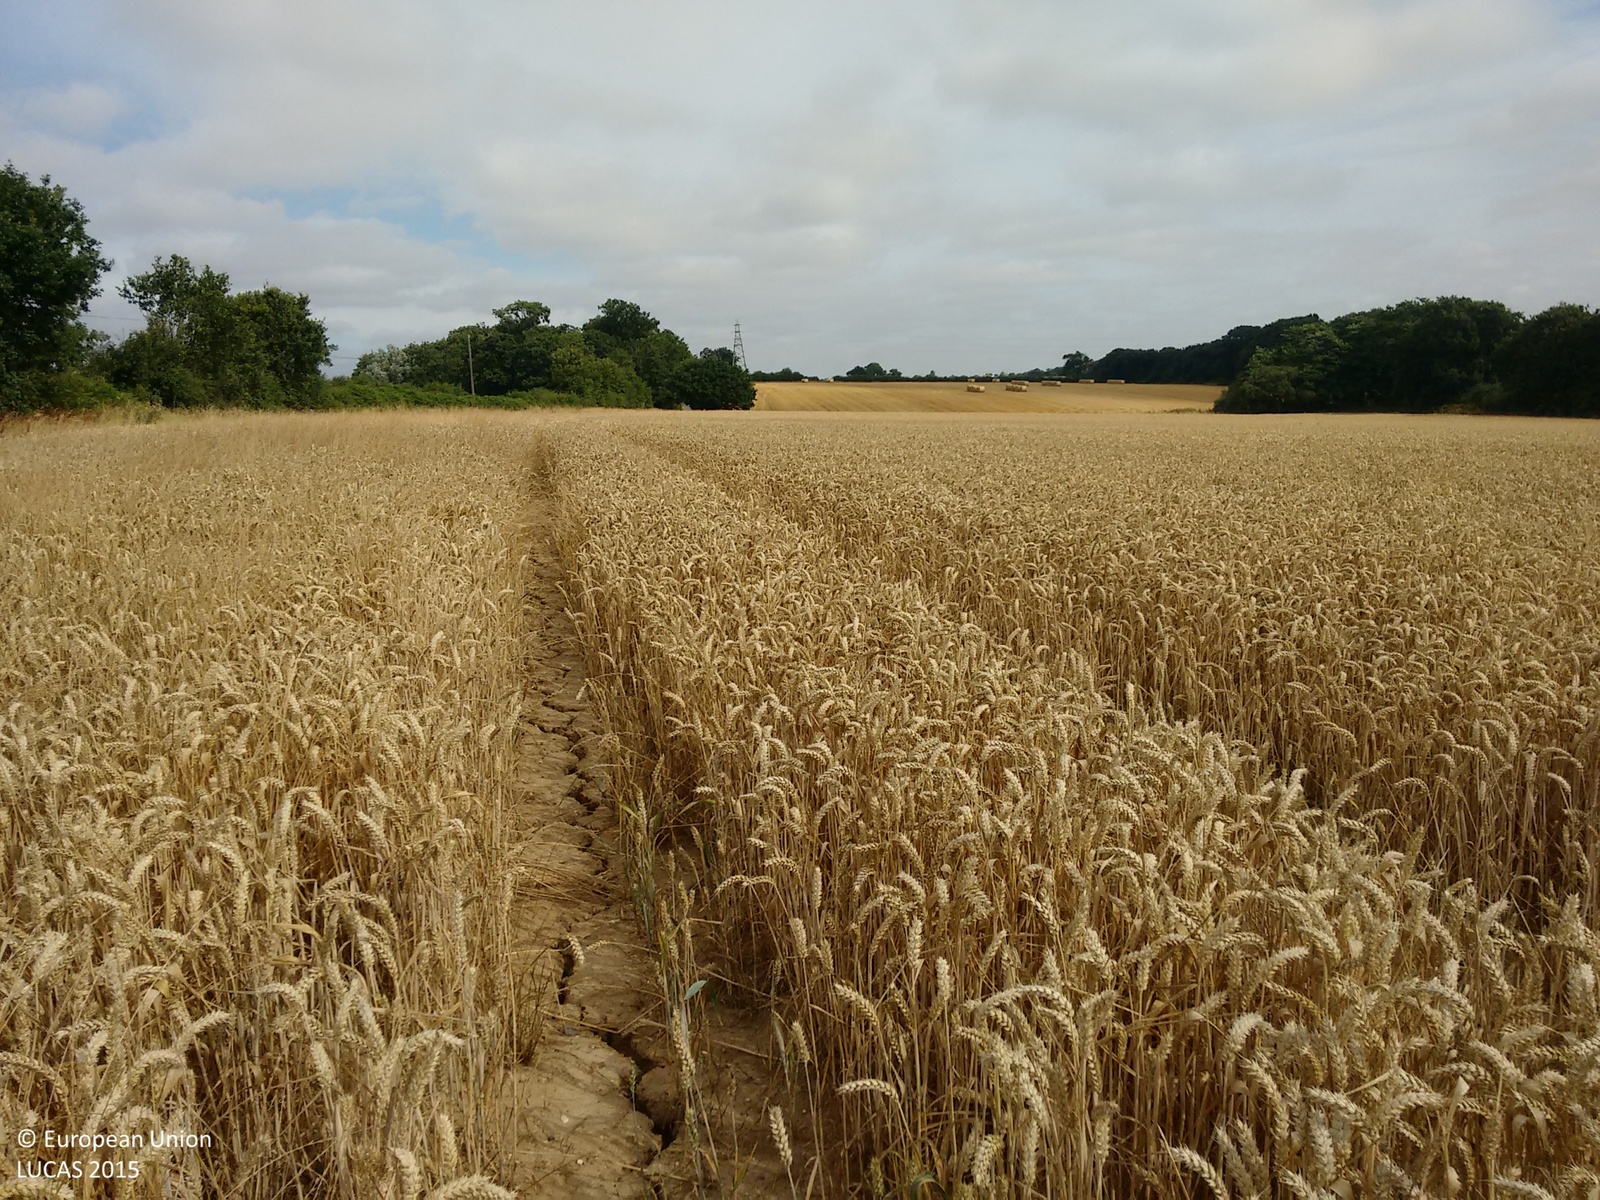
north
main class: Cropland
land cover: Common wheat
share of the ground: > 75 %
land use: Agriculture (excluding fallow land and kitchen gardens)
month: August
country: GB
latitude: 51.8400
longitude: 1.0510
